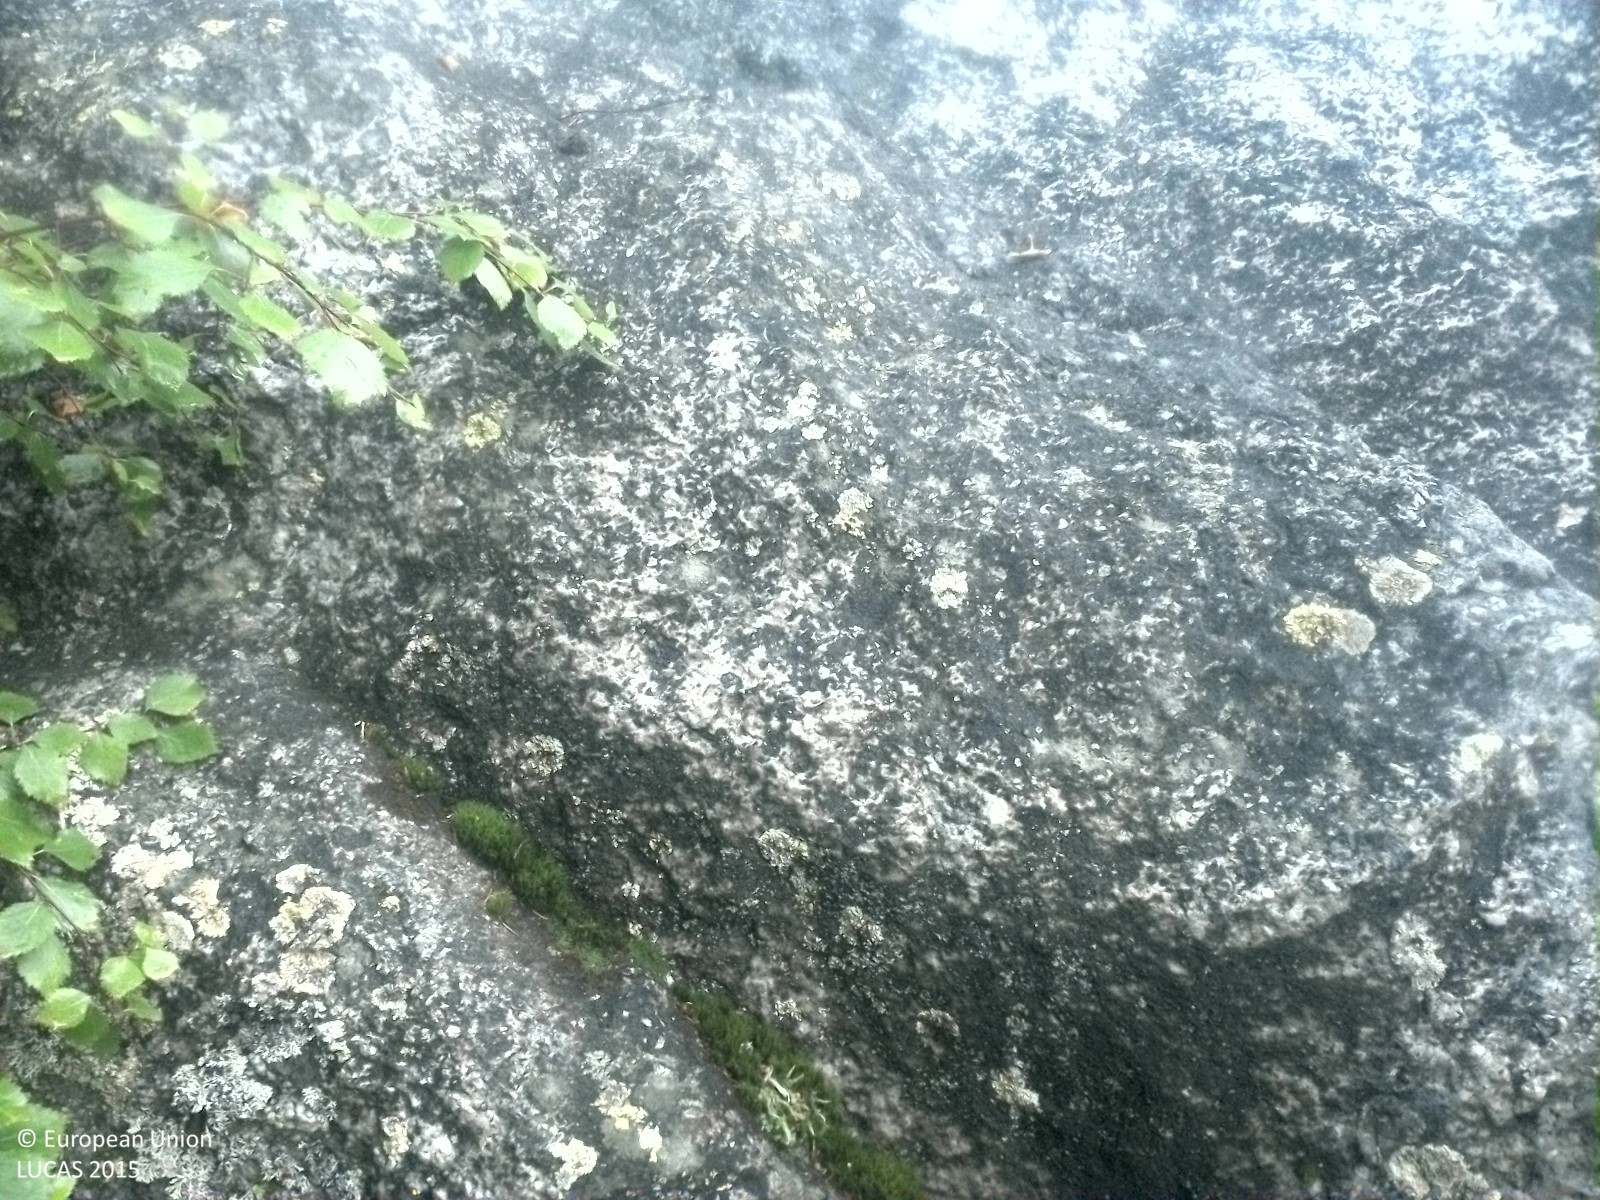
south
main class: Woodland
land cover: Spruce dominated mixed woodland
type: boreal forest
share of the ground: > 75 %
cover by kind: coniferous forest trees 45 %, broadleaved forest trees 30 %, herbaceous plants 25 %
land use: Forestry
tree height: > 5 m
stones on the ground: < 10 %
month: August
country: SE
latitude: 62.6173
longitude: 16.8973
